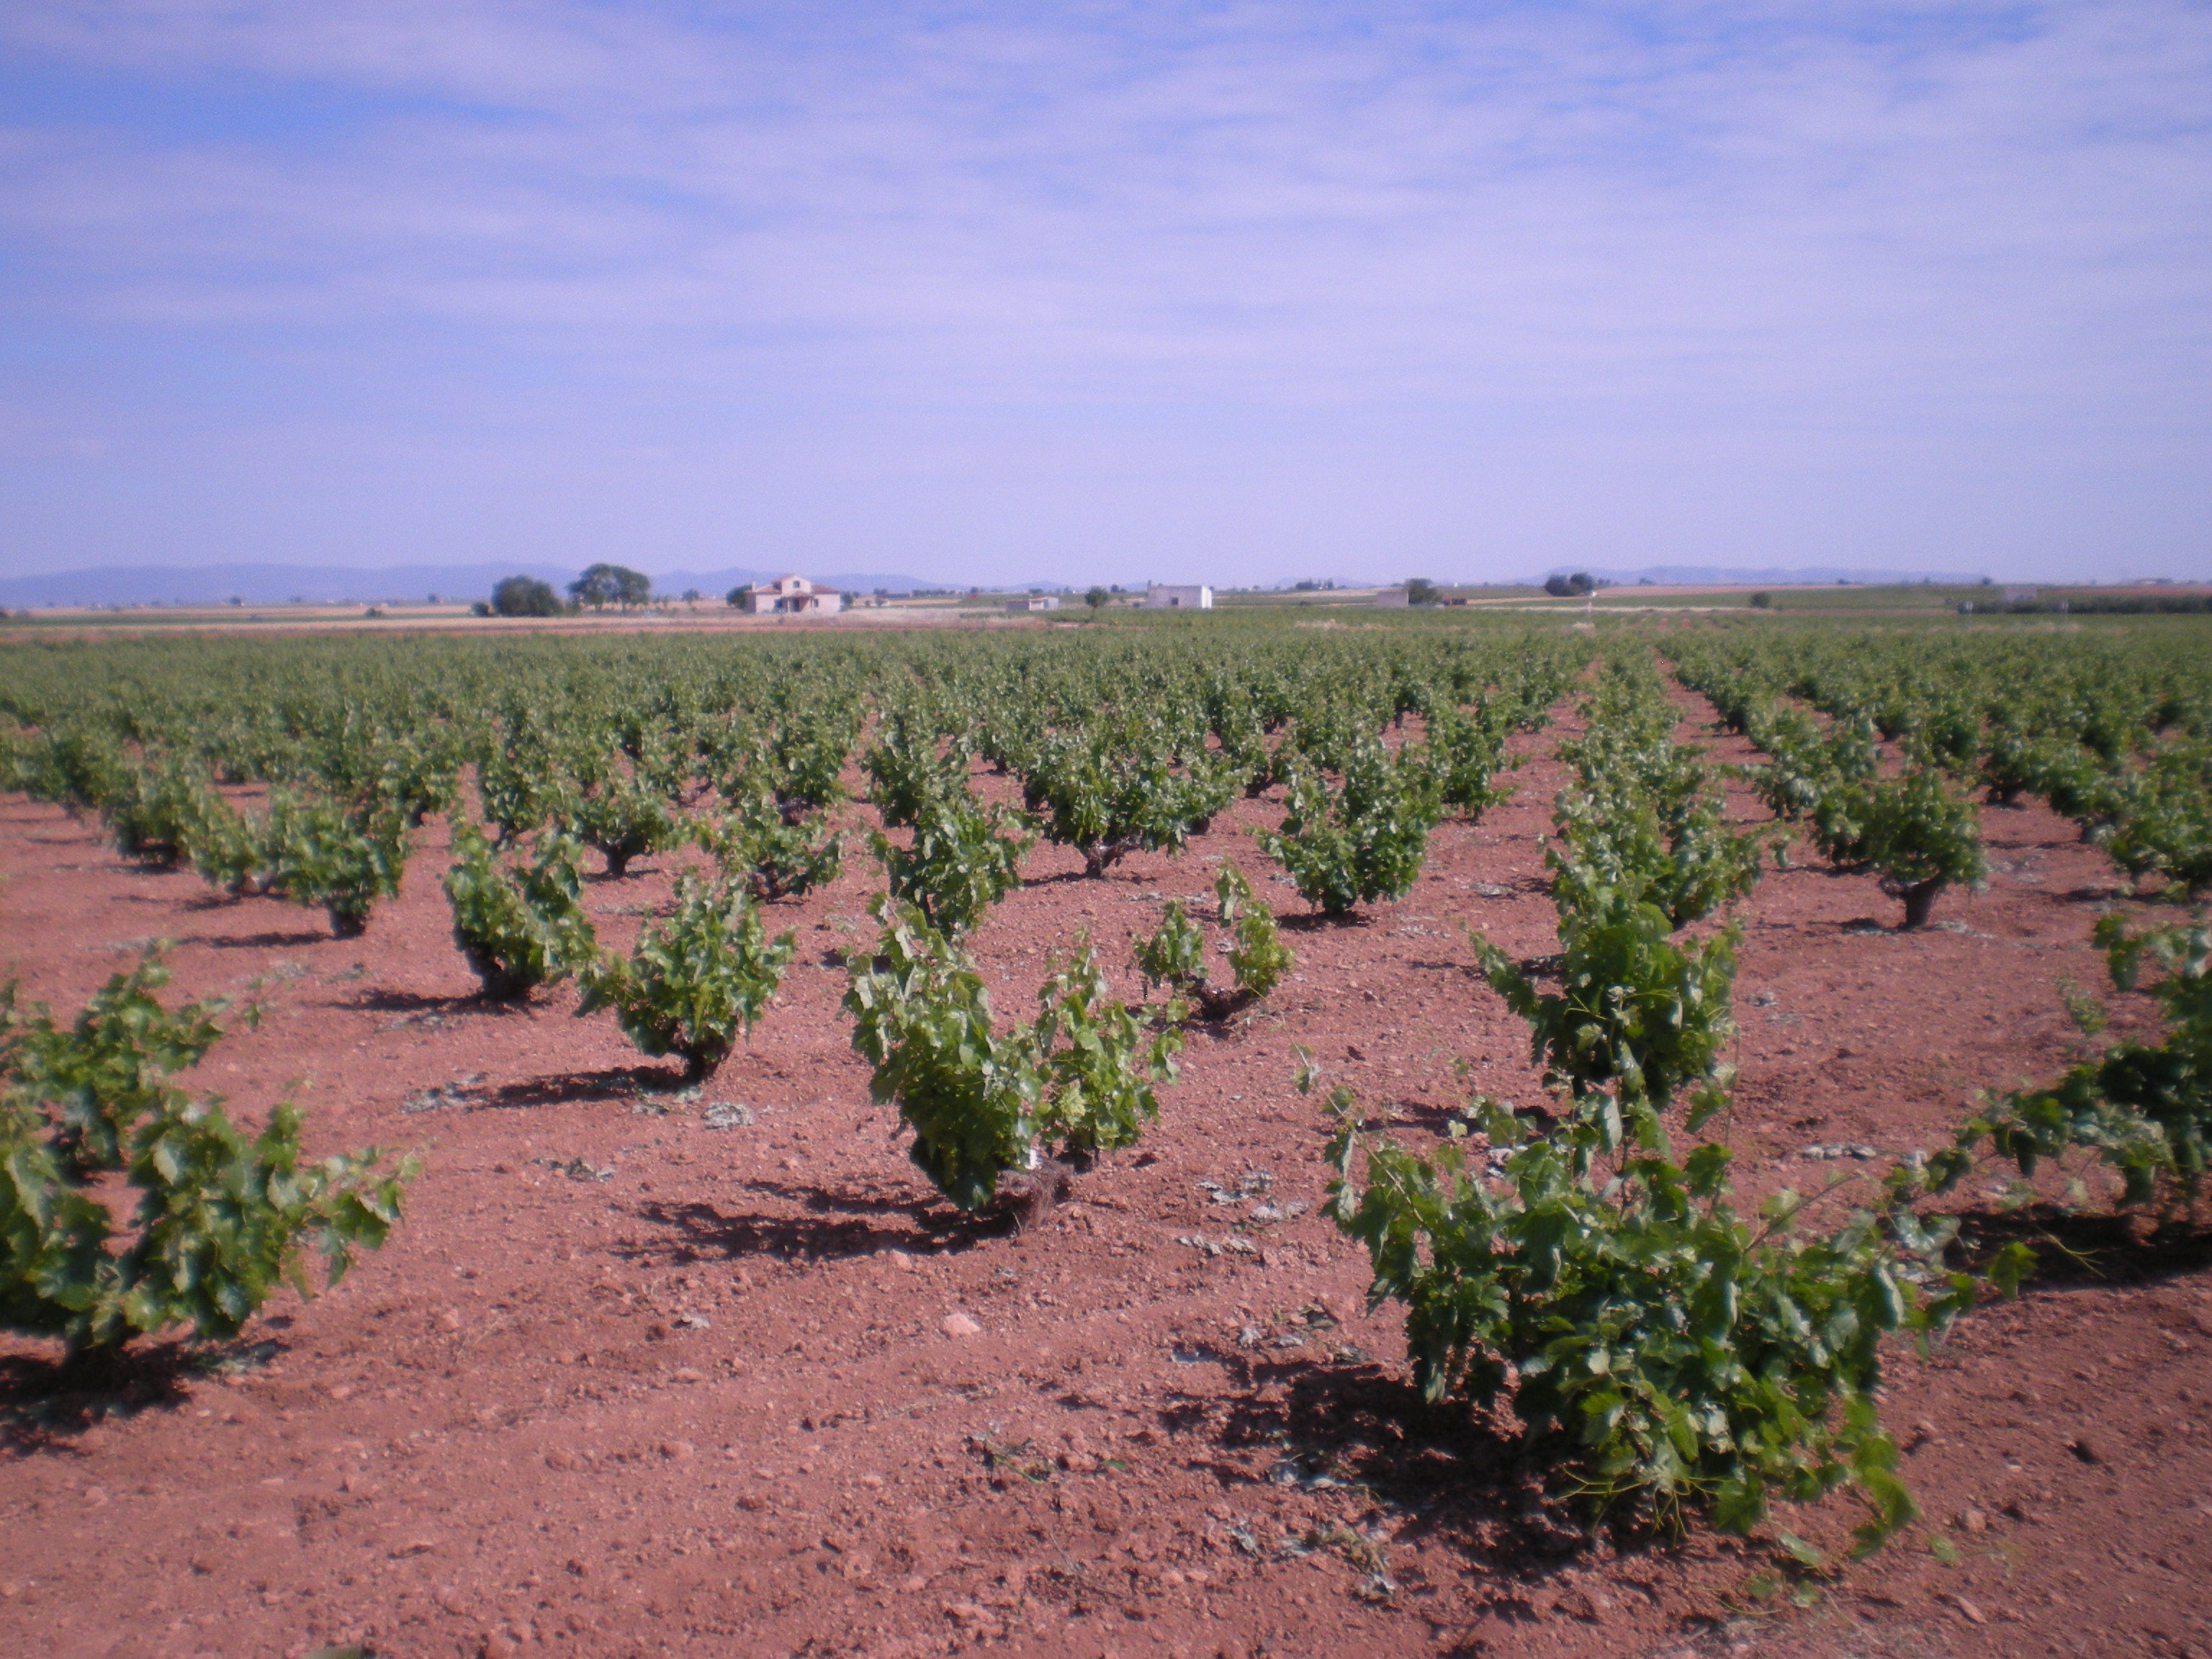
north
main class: Cropland
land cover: Vineyards
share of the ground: 10 - 25 %
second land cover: Other bare soil
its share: > 75 %
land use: Agriculture (excluding fallow land and kitchen gardens)
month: May
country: ES
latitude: 39.0462
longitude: -3.4300
